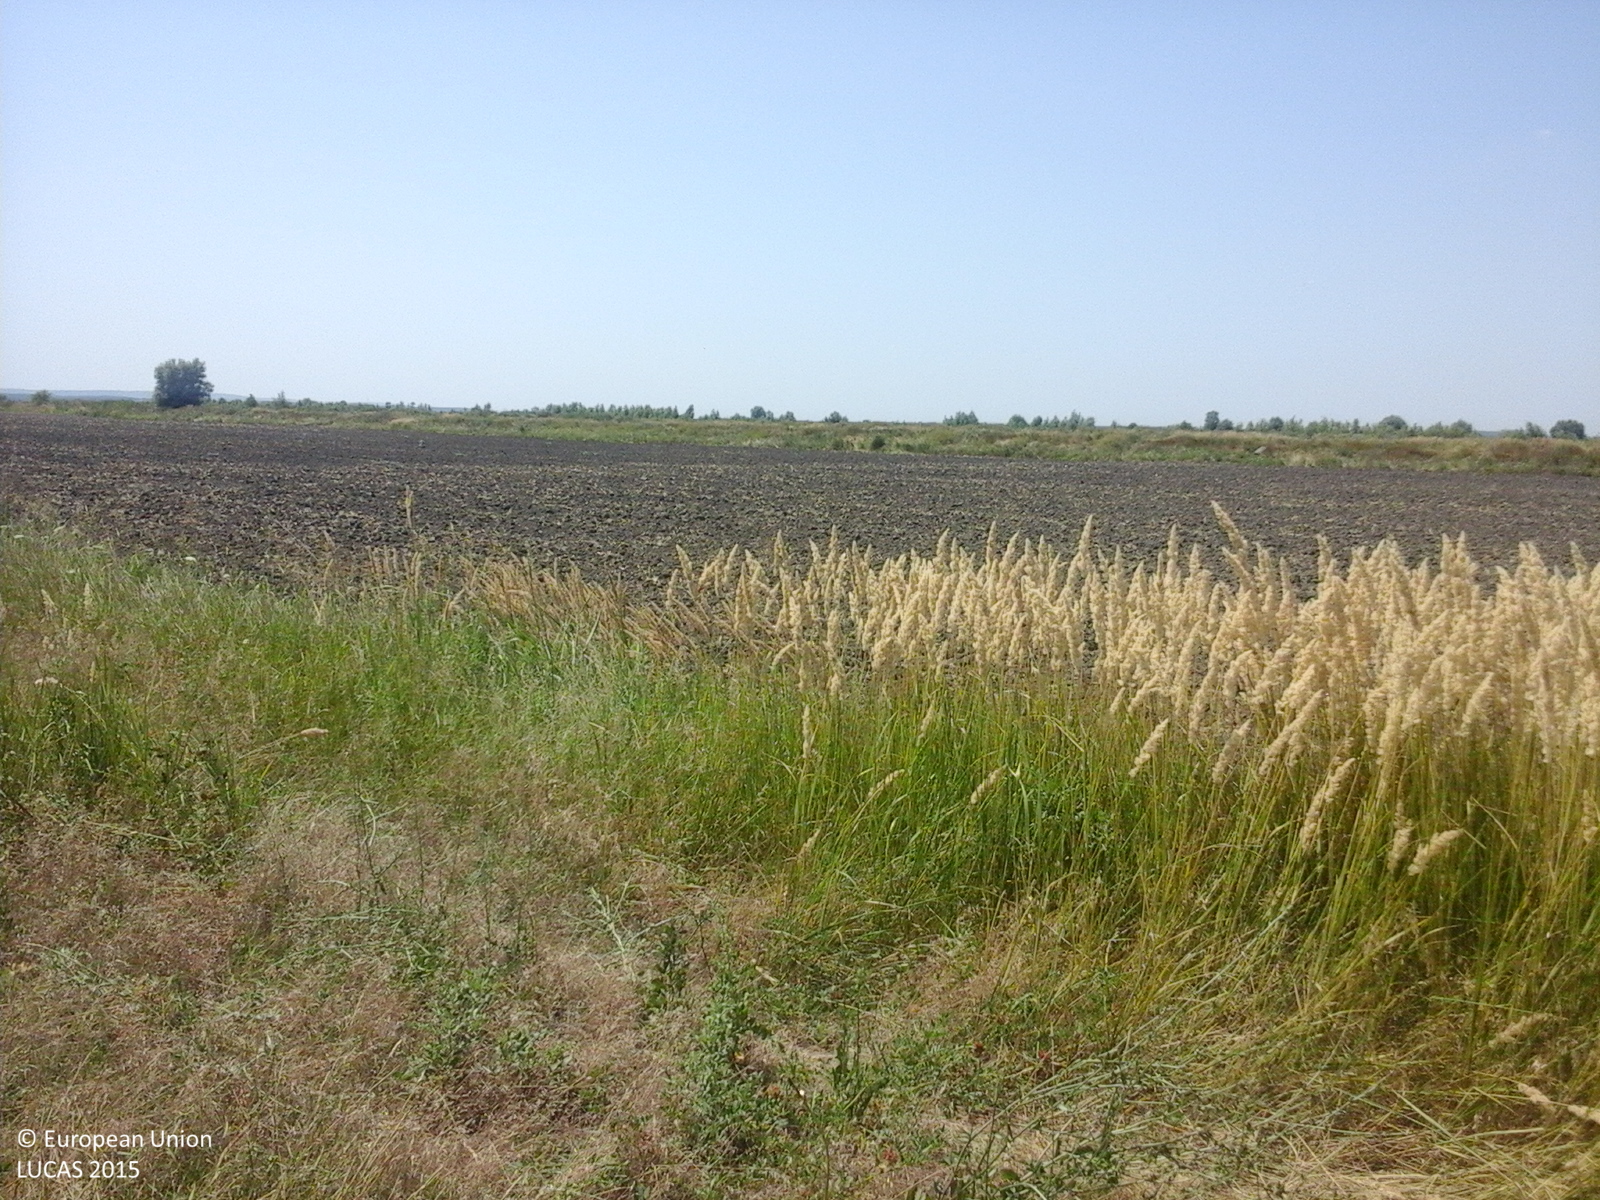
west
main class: Grassland
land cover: Spontaneously vegetated surfaces
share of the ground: > 75 %
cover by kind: herbaceous plants 100 %
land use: Semi-natural and natural areas not in use
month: July
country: RO
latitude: 44.1602
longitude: 27.4824
